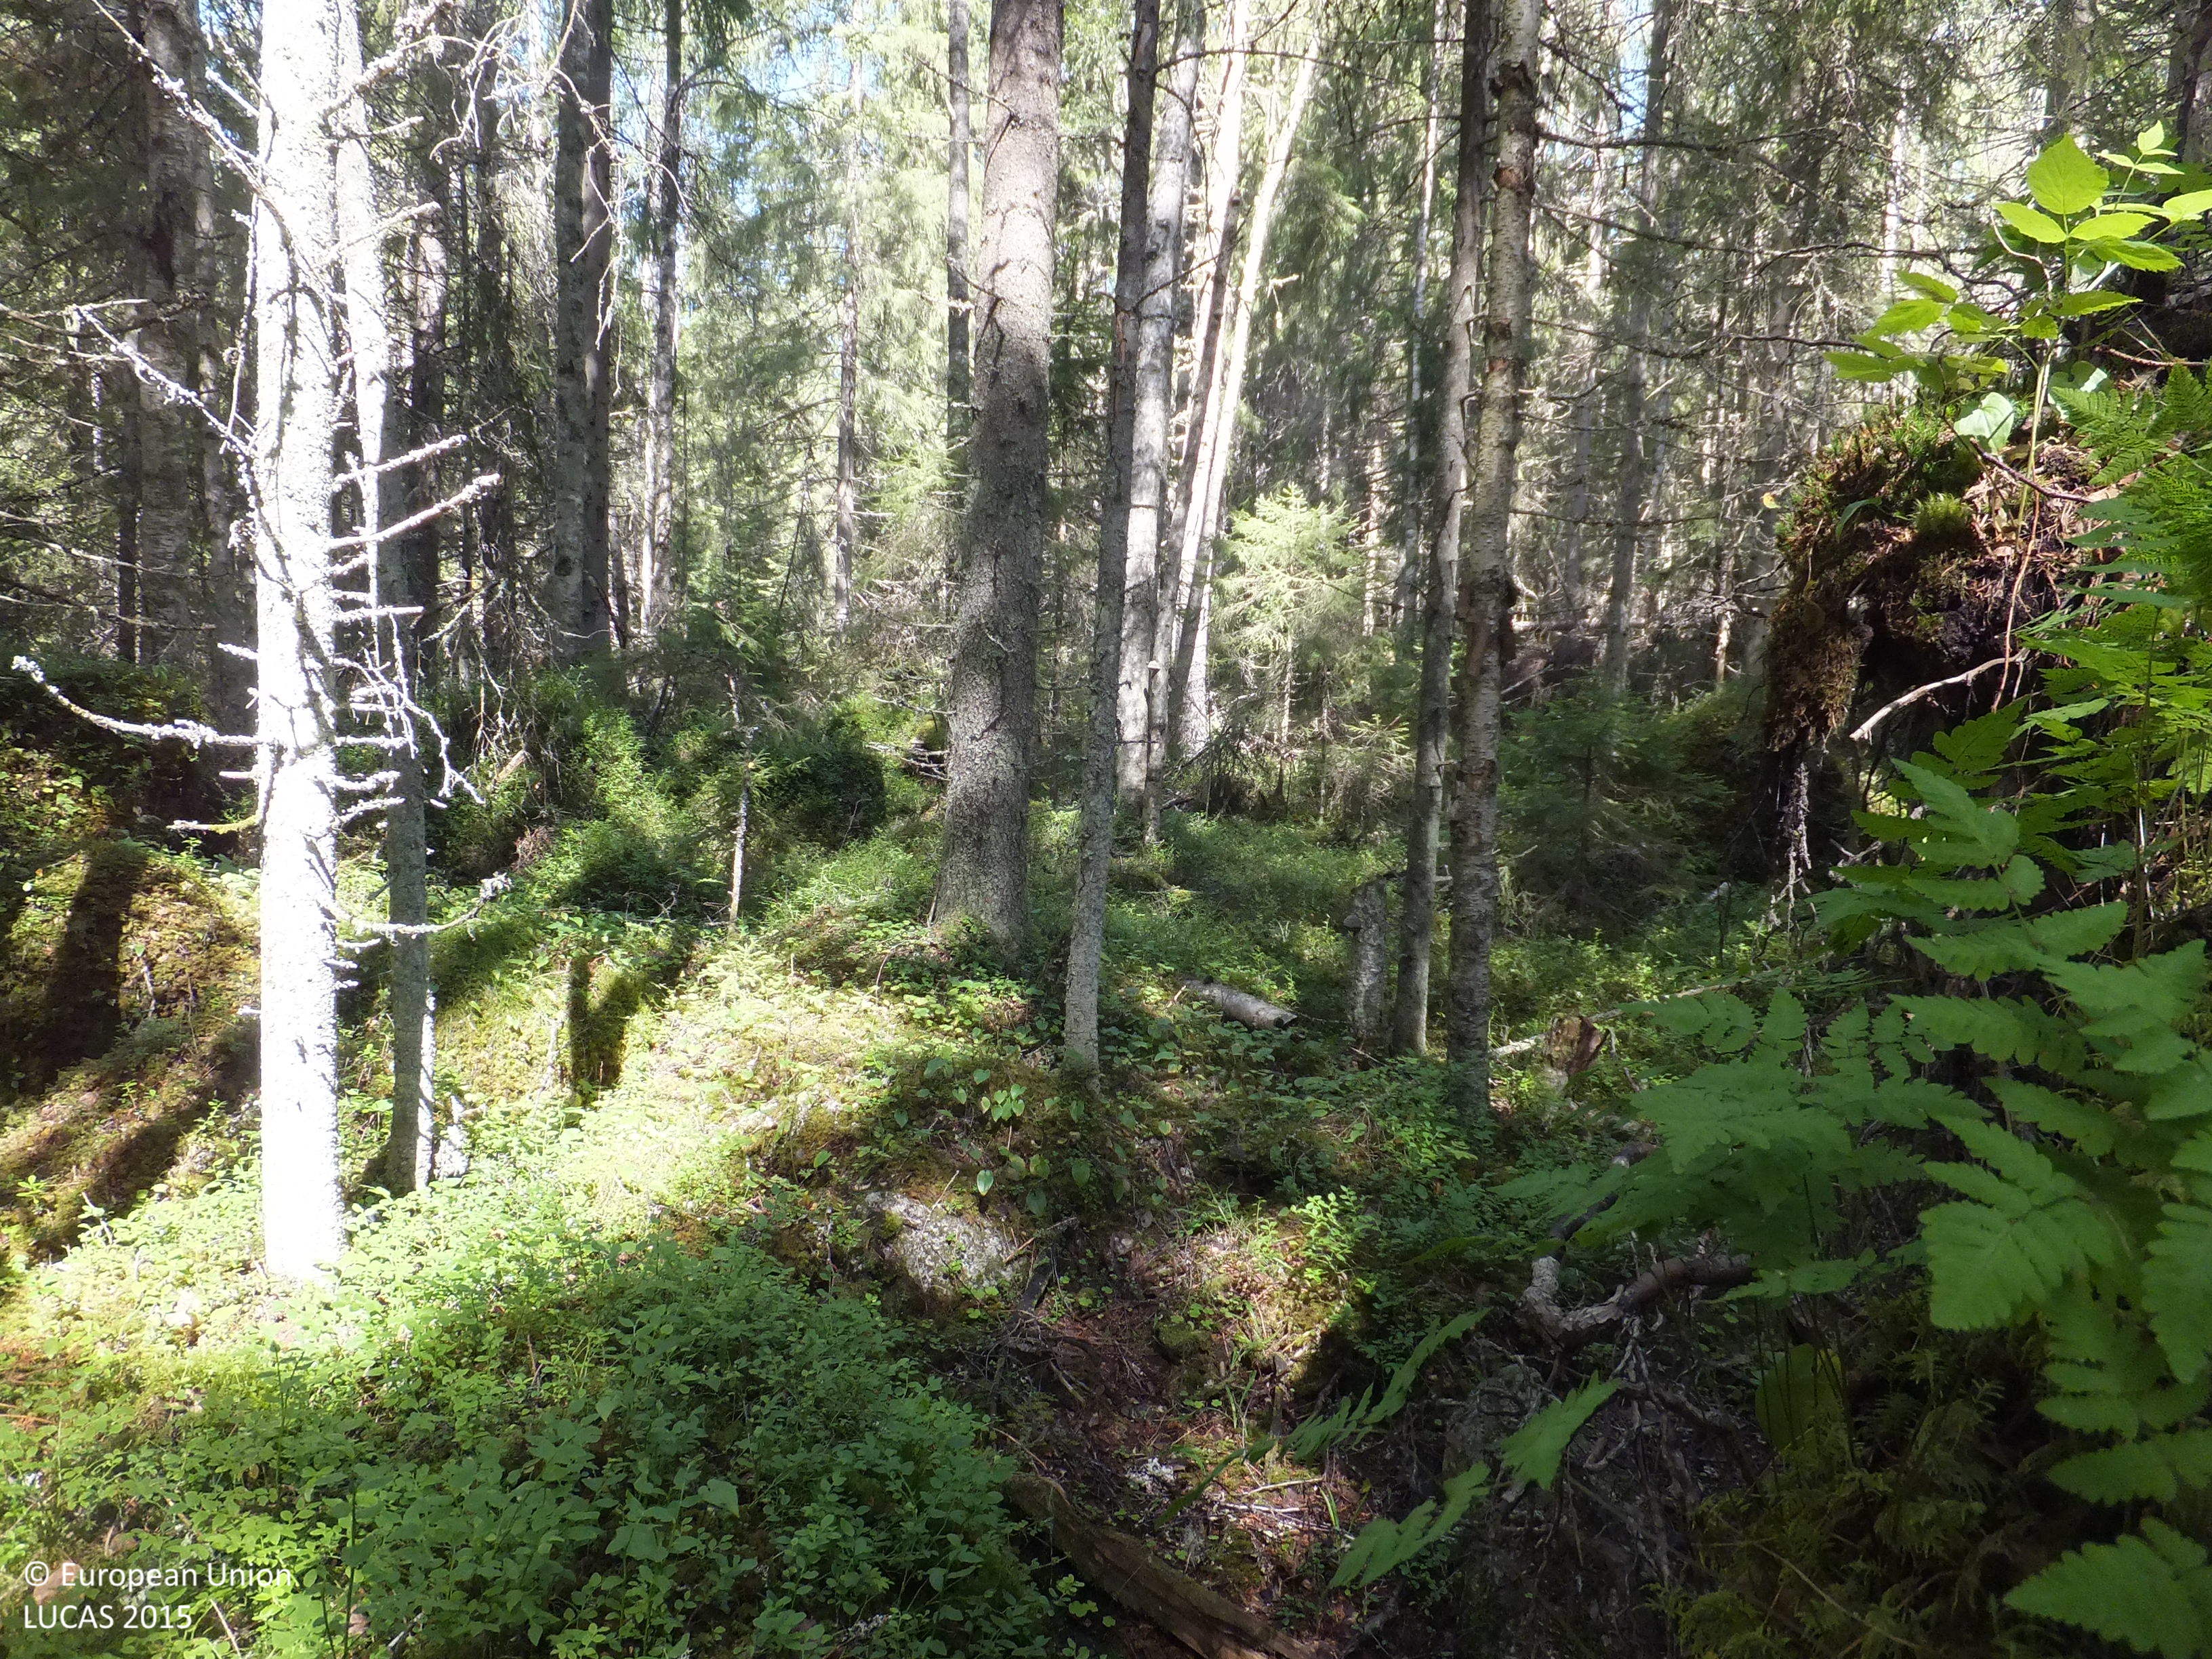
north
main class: Woodland
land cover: Spruce dominated mixed woodland
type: boreal forest
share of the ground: > 75 %
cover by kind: coniferous forest trees 50 %, broadleaved forest trees 30 %, shrubs 10 %, lichens and mosses 10 %
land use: Forestry
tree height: > 5 m
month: August
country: FI
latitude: 63.0994
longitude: 22.2310
